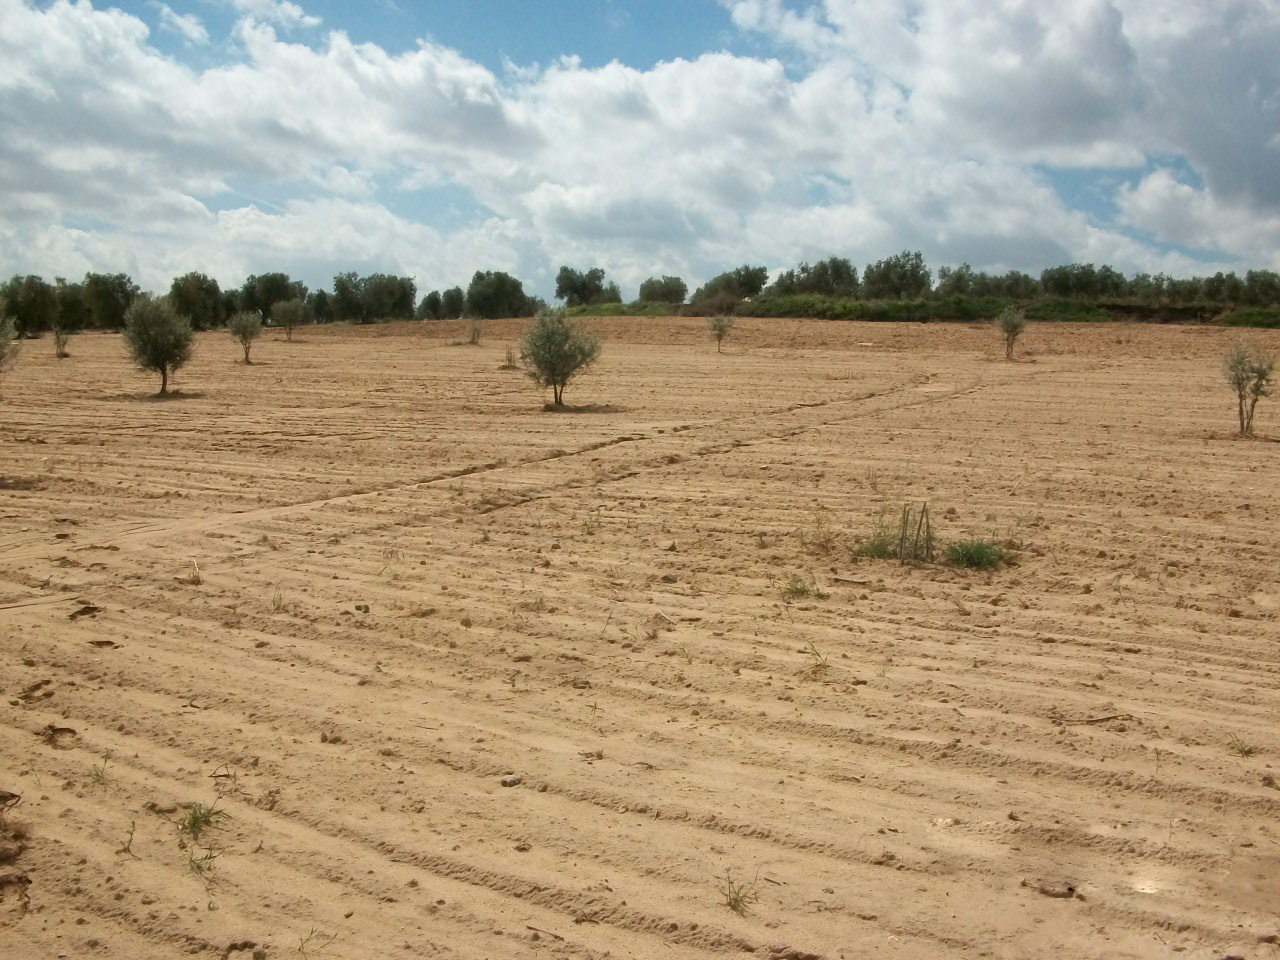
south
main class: Cropland
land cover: Olive groves
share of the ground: 10 - 25 %
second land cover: Other bare soil
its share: > 75 %
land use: Agriculture (excluding fallow land and kitchen gardens)
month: April
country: ES
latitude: 39.8454
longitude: -3.7392
